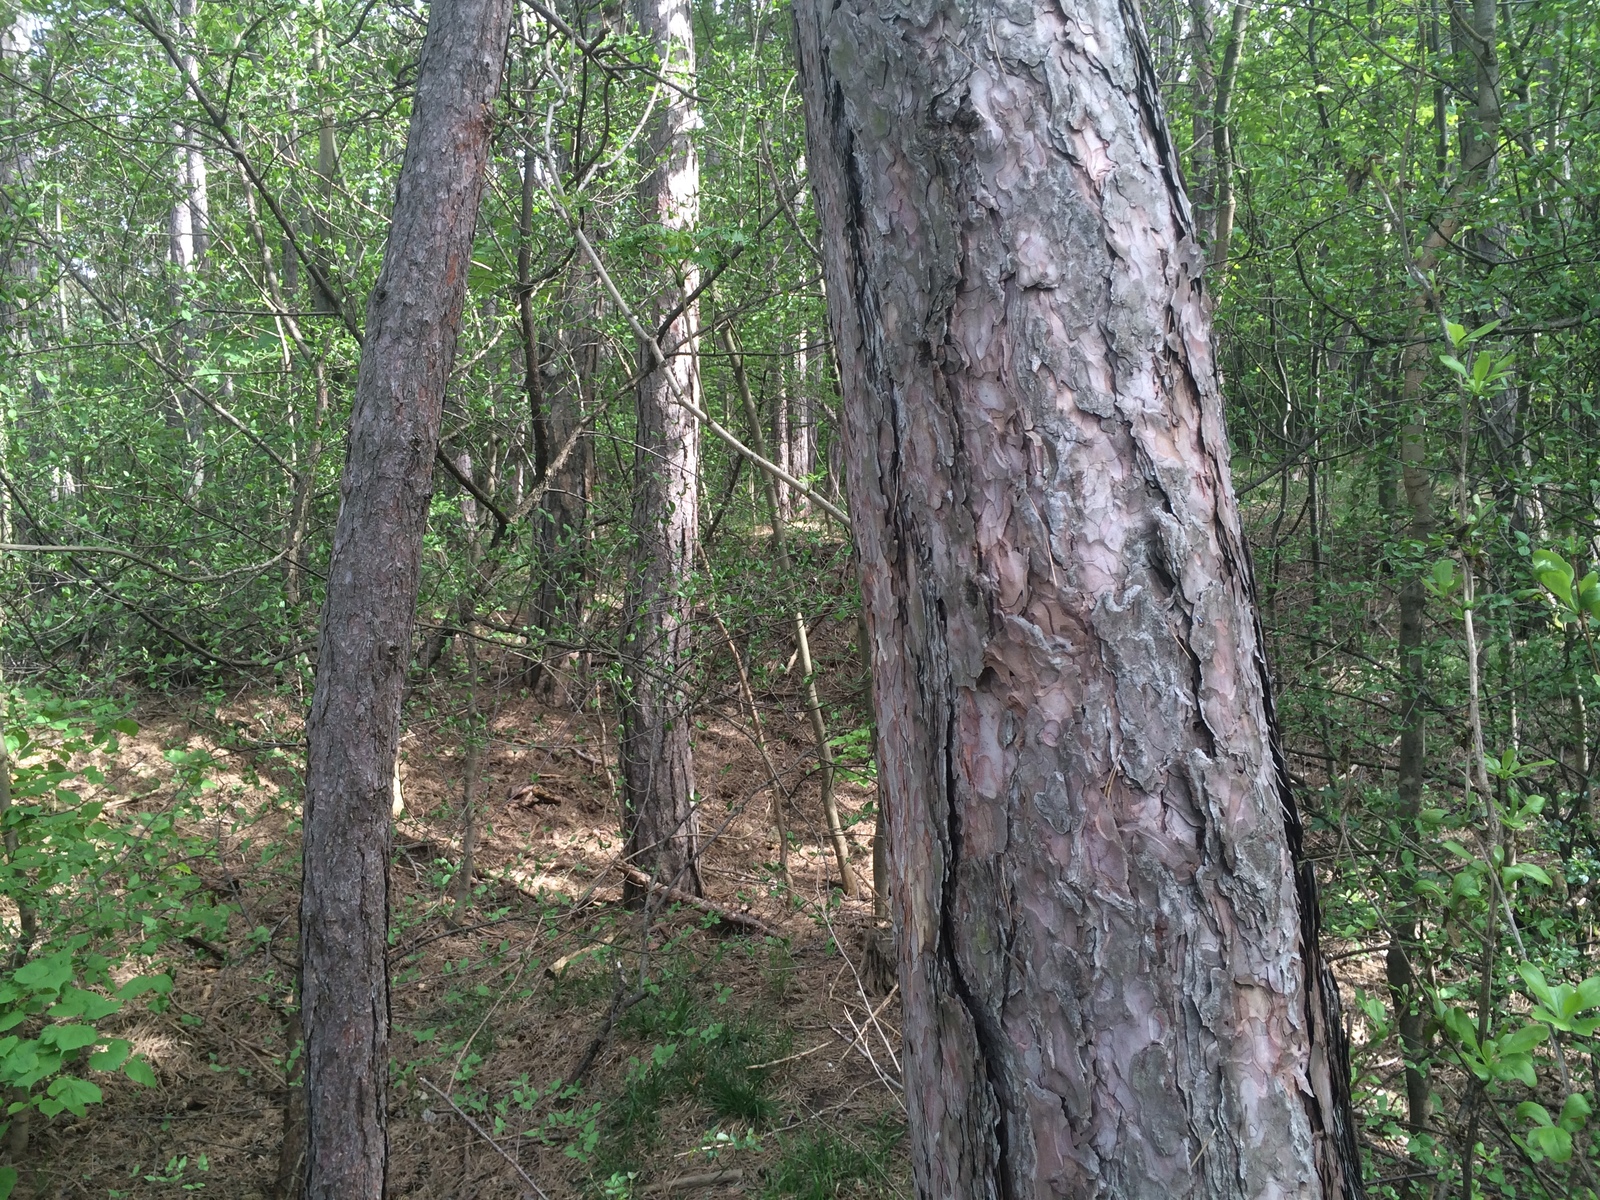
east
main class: Woodland
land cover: Pine dominated mixed woodland
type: hemiboreal forest and nemoral coniferous forest and mixed broadleaved-coniferous forest
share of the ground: > 75 %
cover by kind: coniferous forest trees 65 %, broadleaved forest trees 25 %, herbaceous plants 10 %
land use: Forestry
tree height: > 5 m
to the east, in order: Pine dominated mixed woodland; Tracks; Pine dominated mixed woodland; Rye; Grass margins; Tracks; Grass margins; Rye; Barley; Grass margins; Dry stone walls
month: May
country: AT
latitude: 47.8913
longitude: 16.1156
